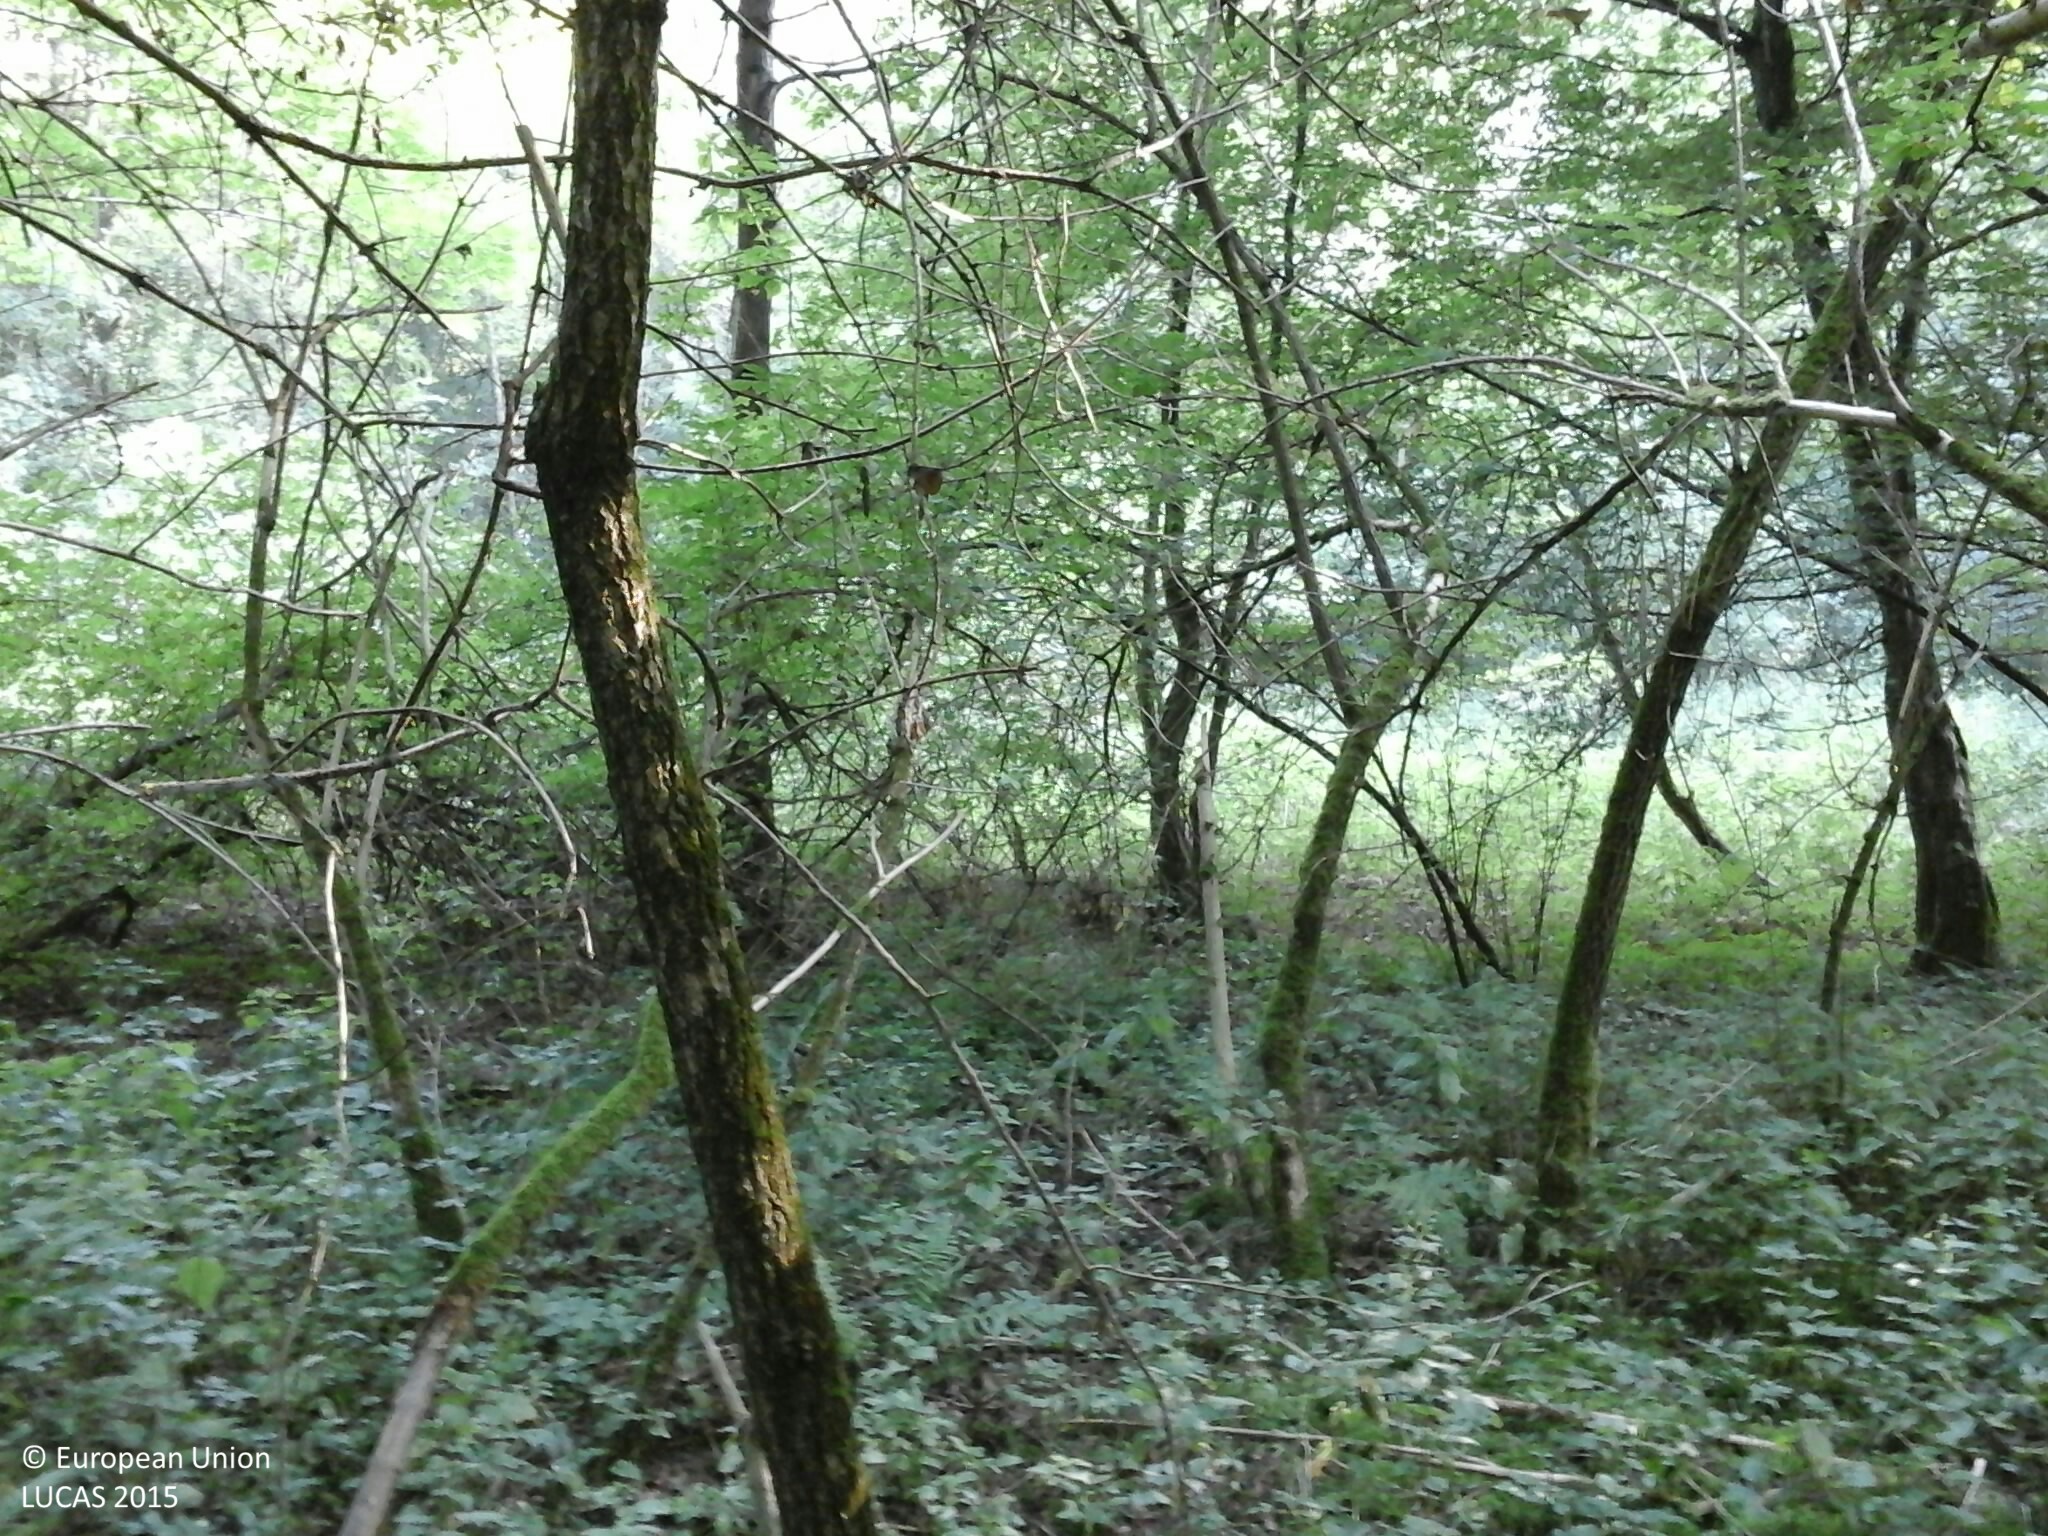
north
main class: Woodland
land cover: Broadleaved woodland
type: mesophytic deciduous forest
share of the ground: > 75 %
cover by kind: broadleaved forest trees 85 %, shrubs 10 %, herbaceous plants 5 %
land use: Forestry
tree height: > 5 m
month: July
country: HU
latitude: 46.9479
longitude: 16.5059
